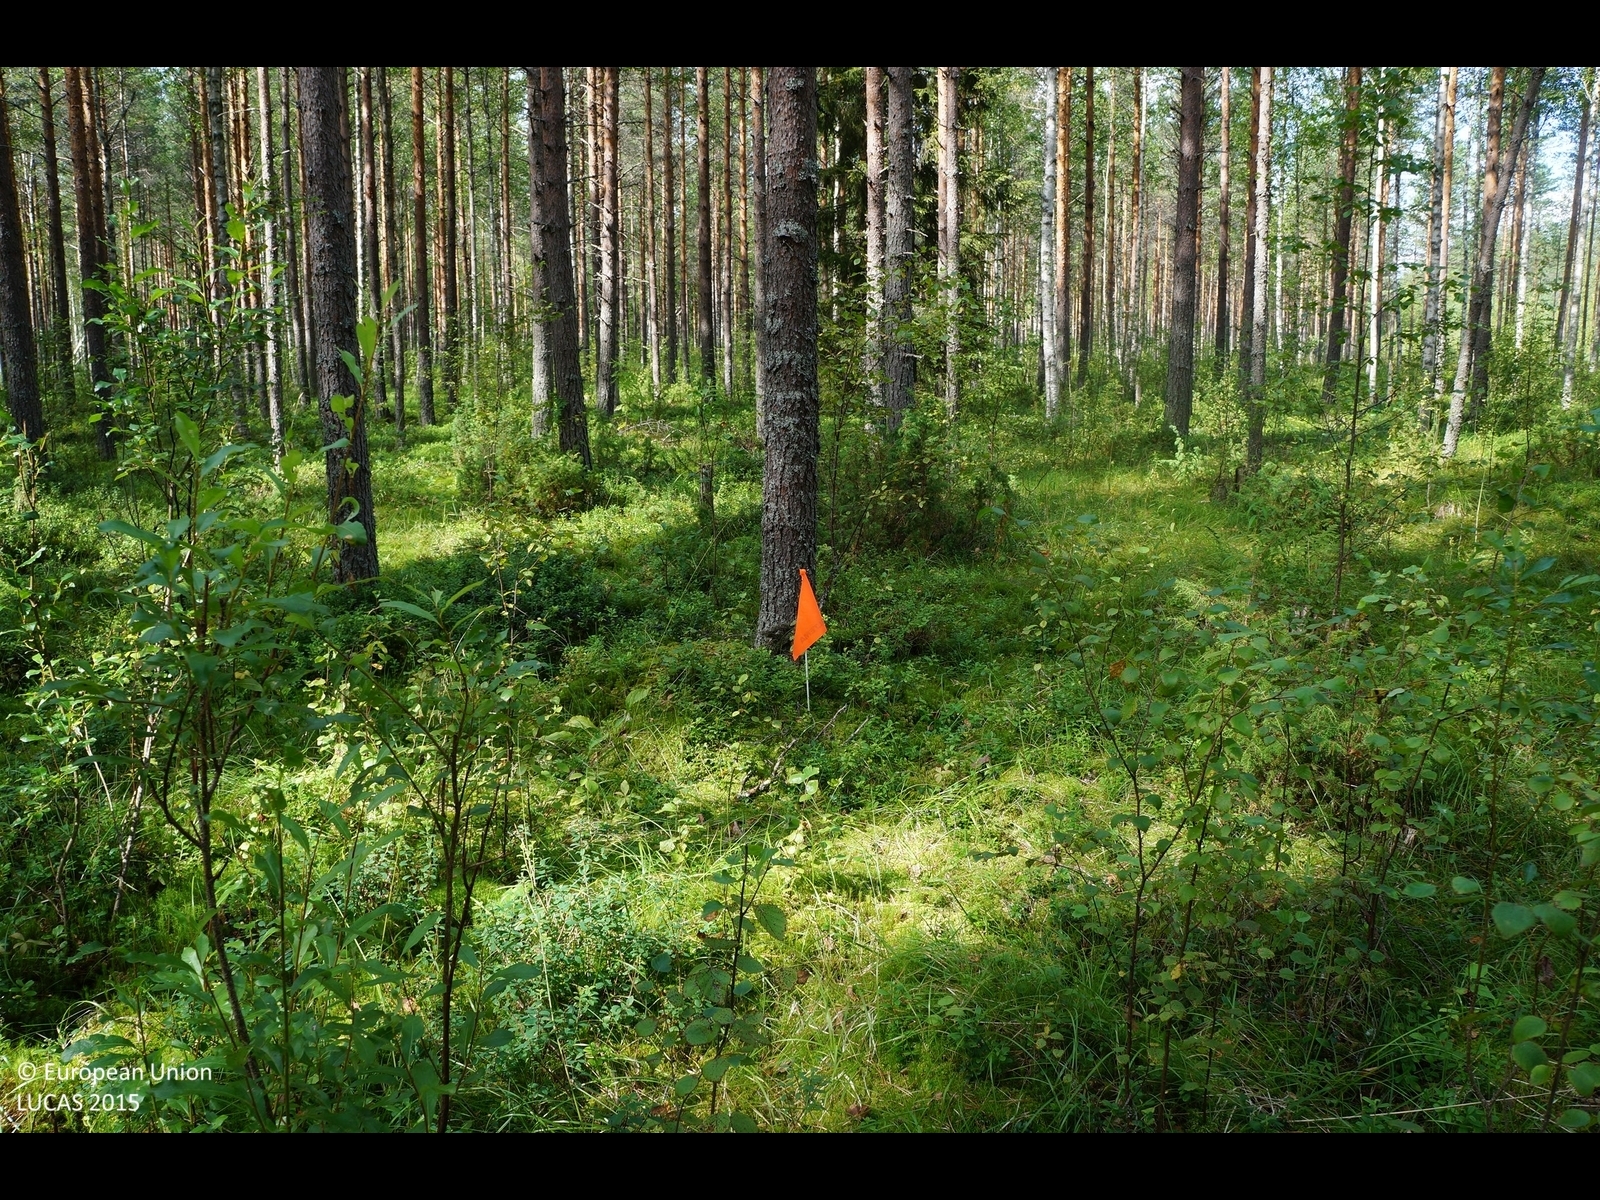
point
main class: Woodland
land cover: Pine dominated coniferous woodland
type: boreal forest
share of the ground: 50 - 75 %
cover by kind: coniferous forest trees 55 %, shrubs 20 %, lichens and mosses 15 %, herbaceous plants 10 %
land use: Forestry
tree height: > 5 m
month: August
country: FI
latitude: 64.4096
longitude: 26.0186
